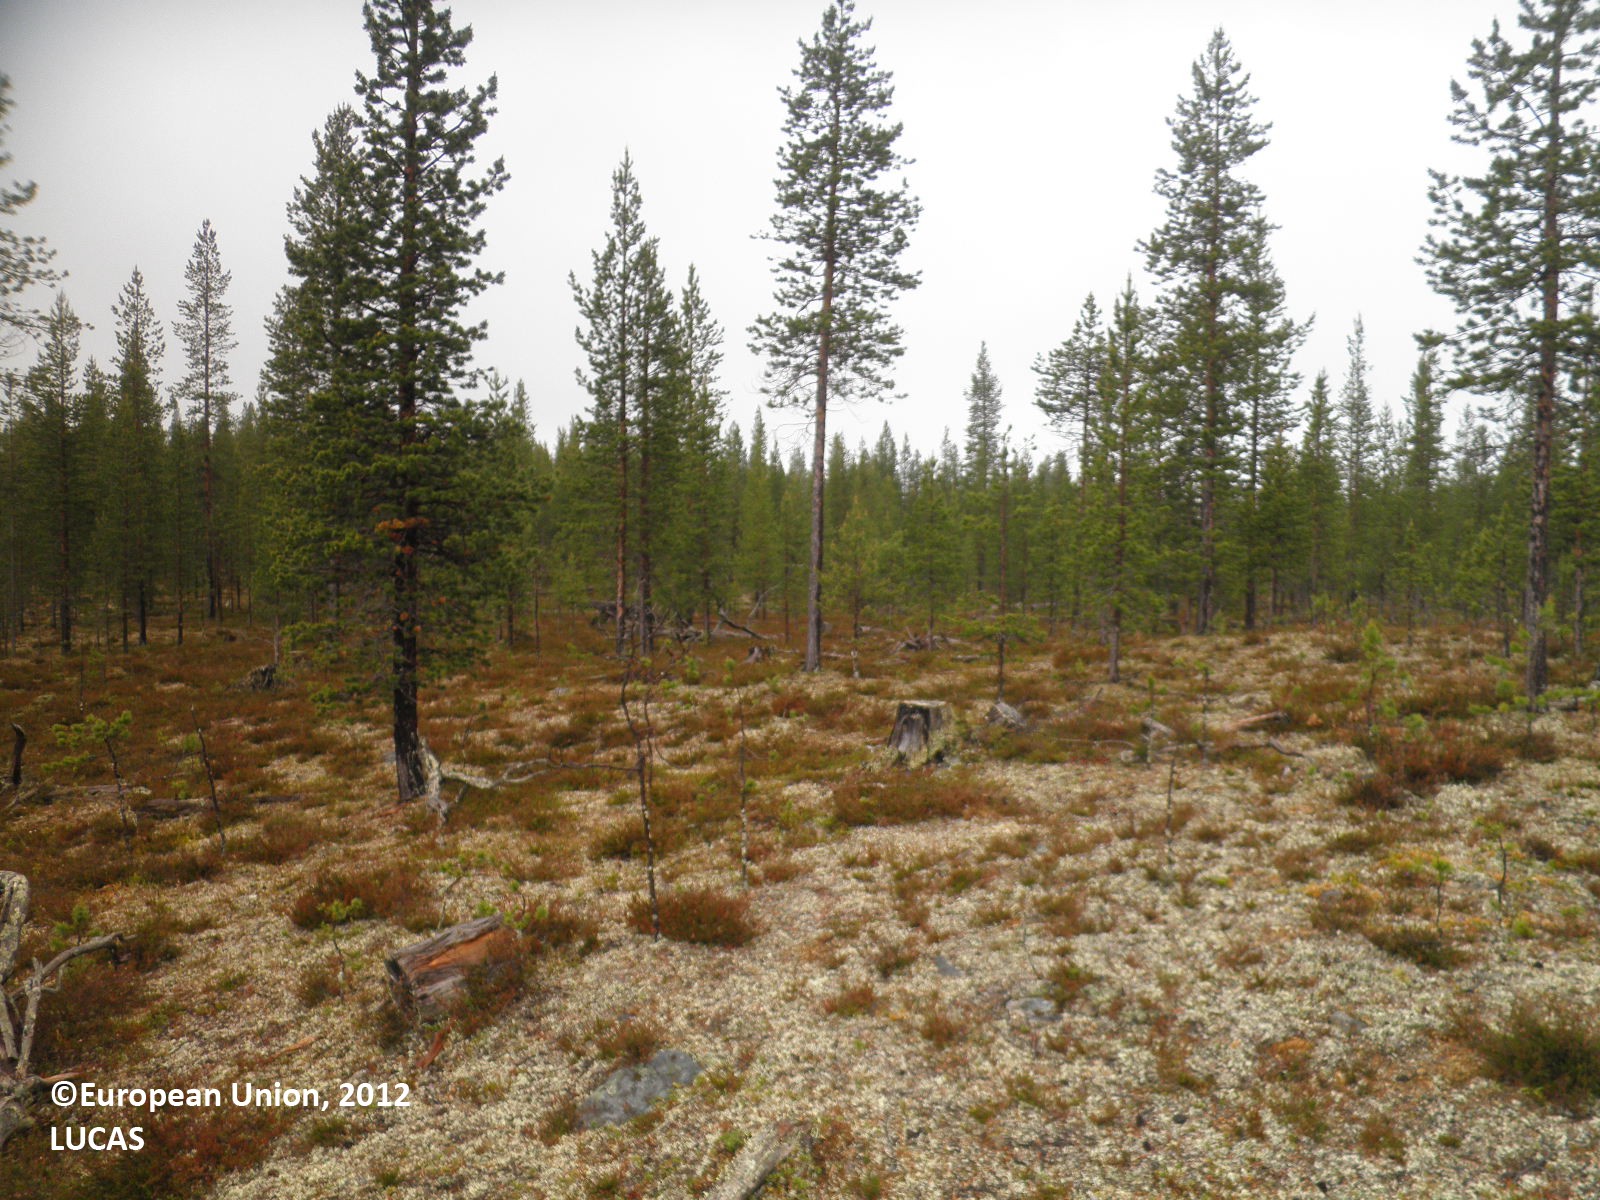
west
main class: Woodland
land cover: Pine dominated coniferous woodland
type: boreal forest
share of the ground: 25 - 50 %
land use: Forestry
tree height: > 5 m
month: June
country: FI
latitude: 68.4796
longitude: 27.7986
